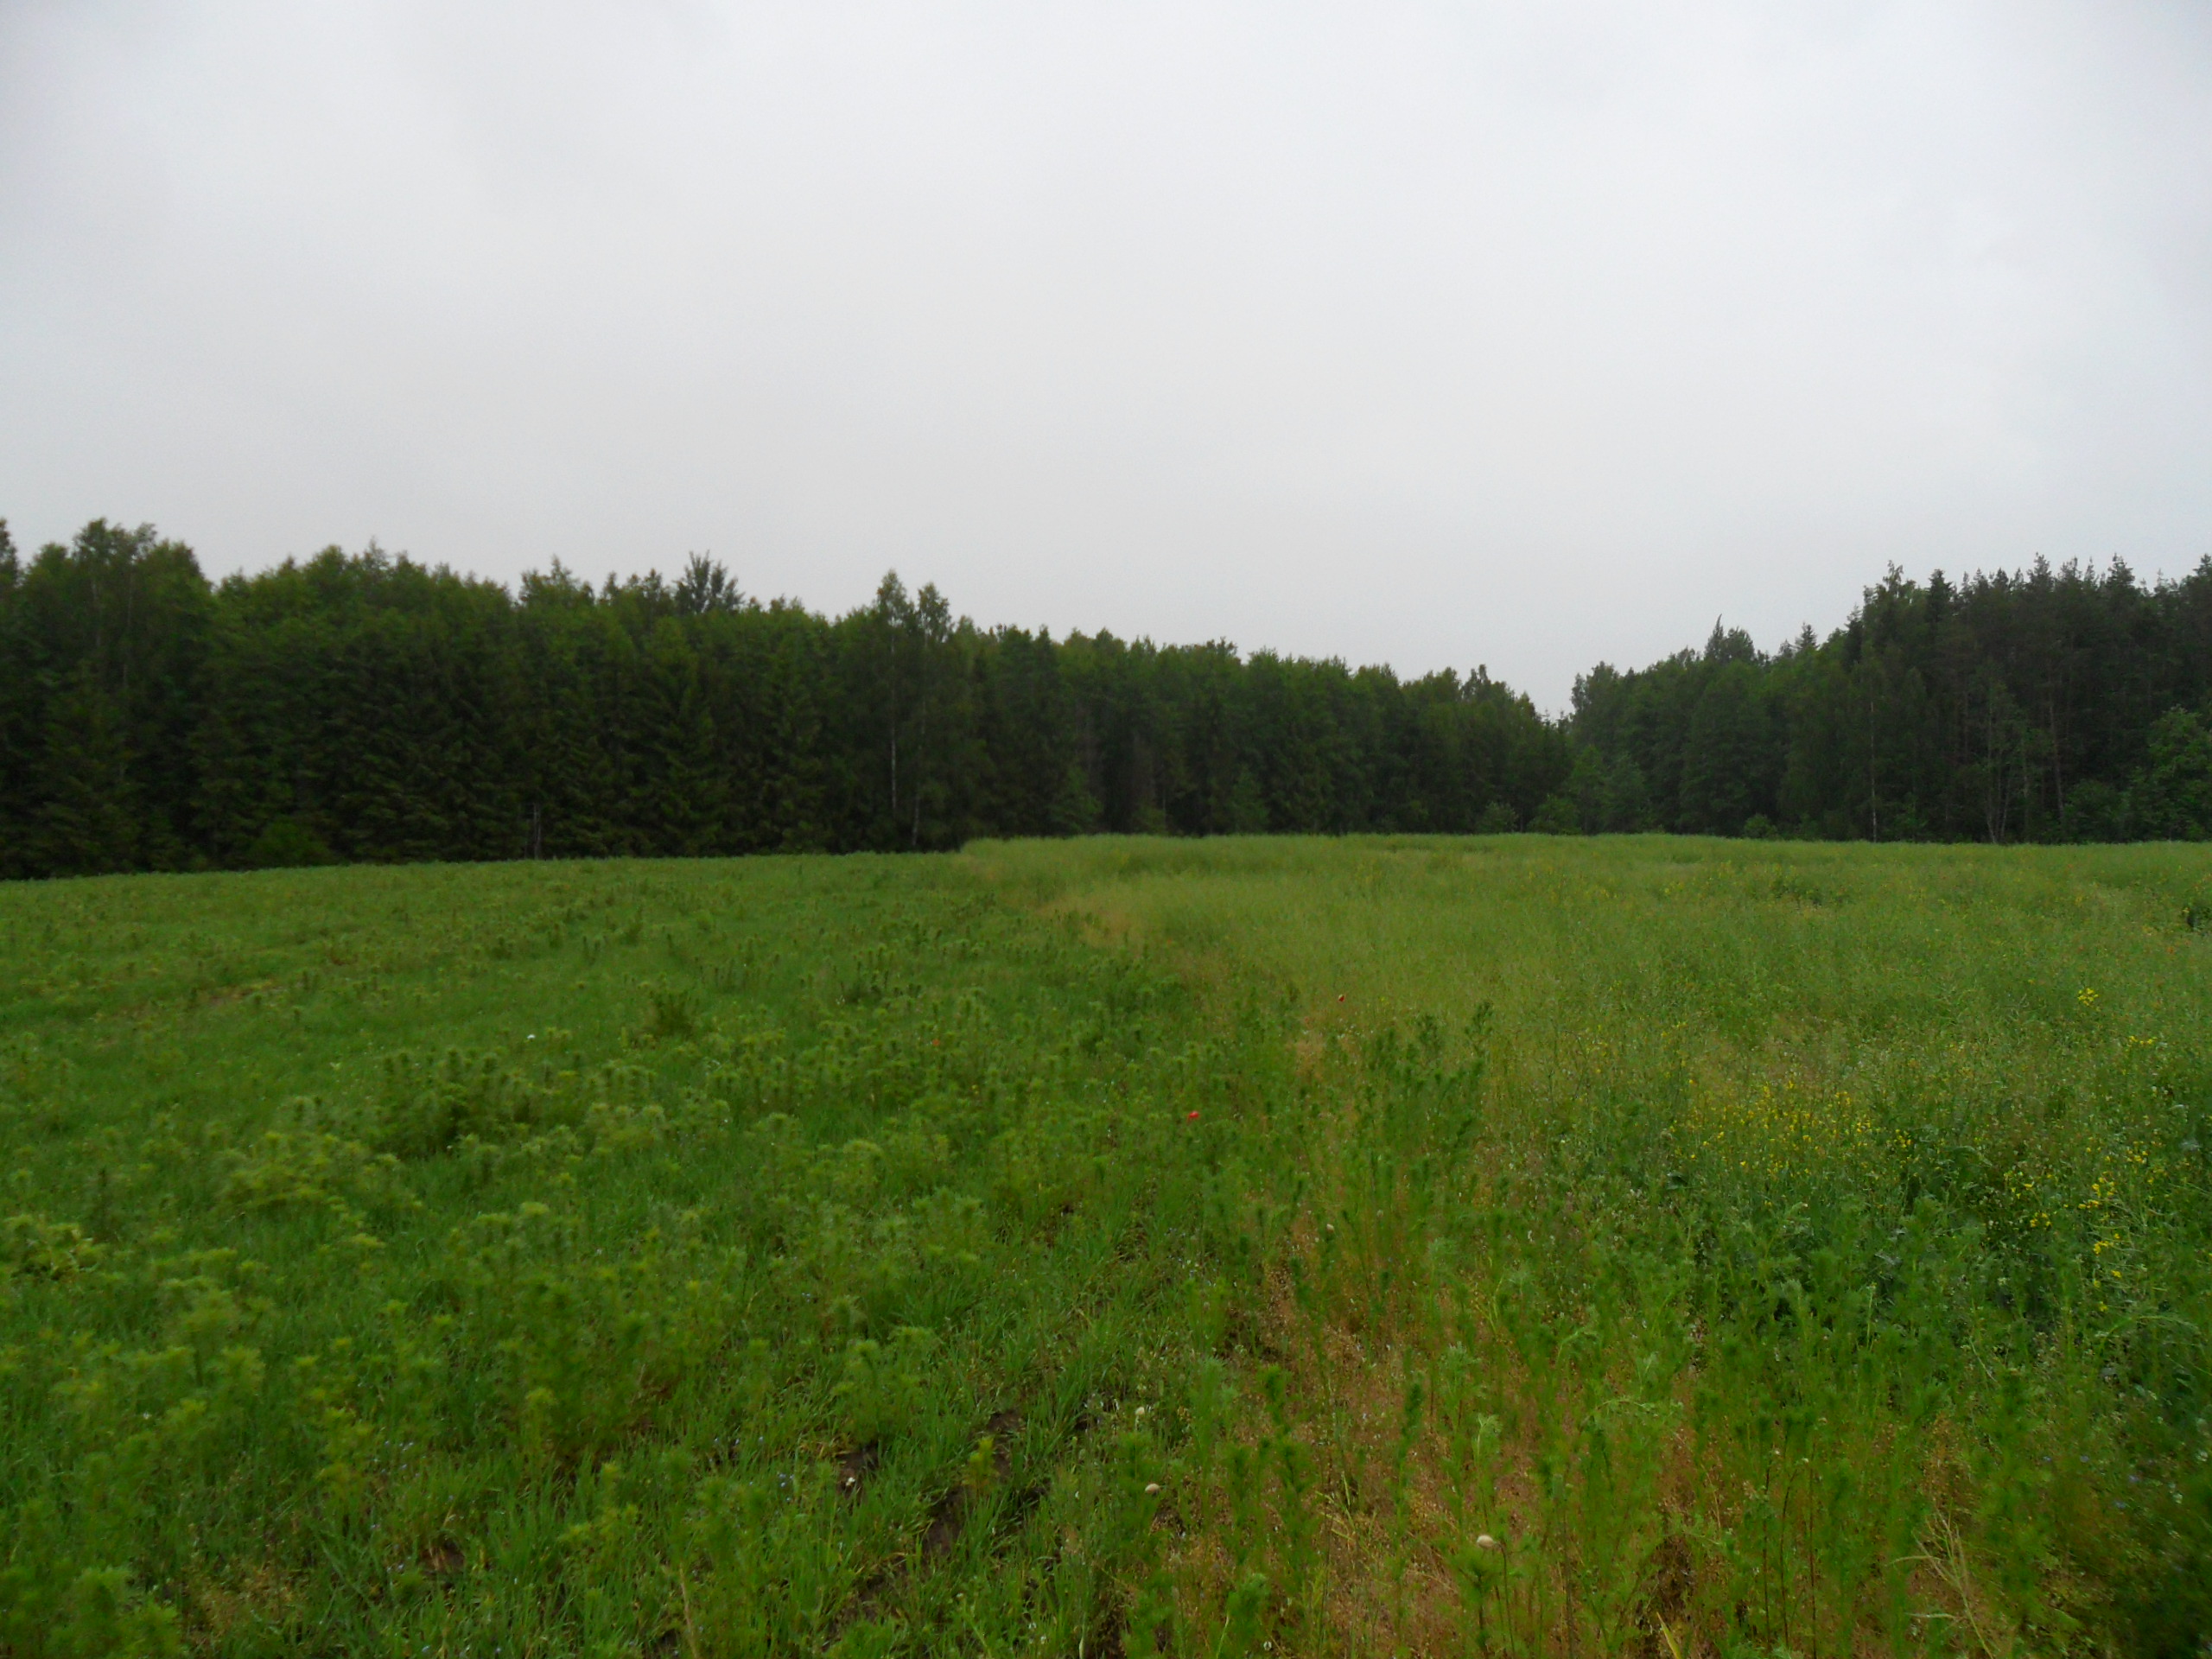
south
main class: Cropland
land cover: Rape and turnip rape
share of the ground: > 75 %
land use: Agriculture (excluding fallow land and kitchen gardens)
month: June
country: LV
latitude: 57.3723
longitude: 22.1709
